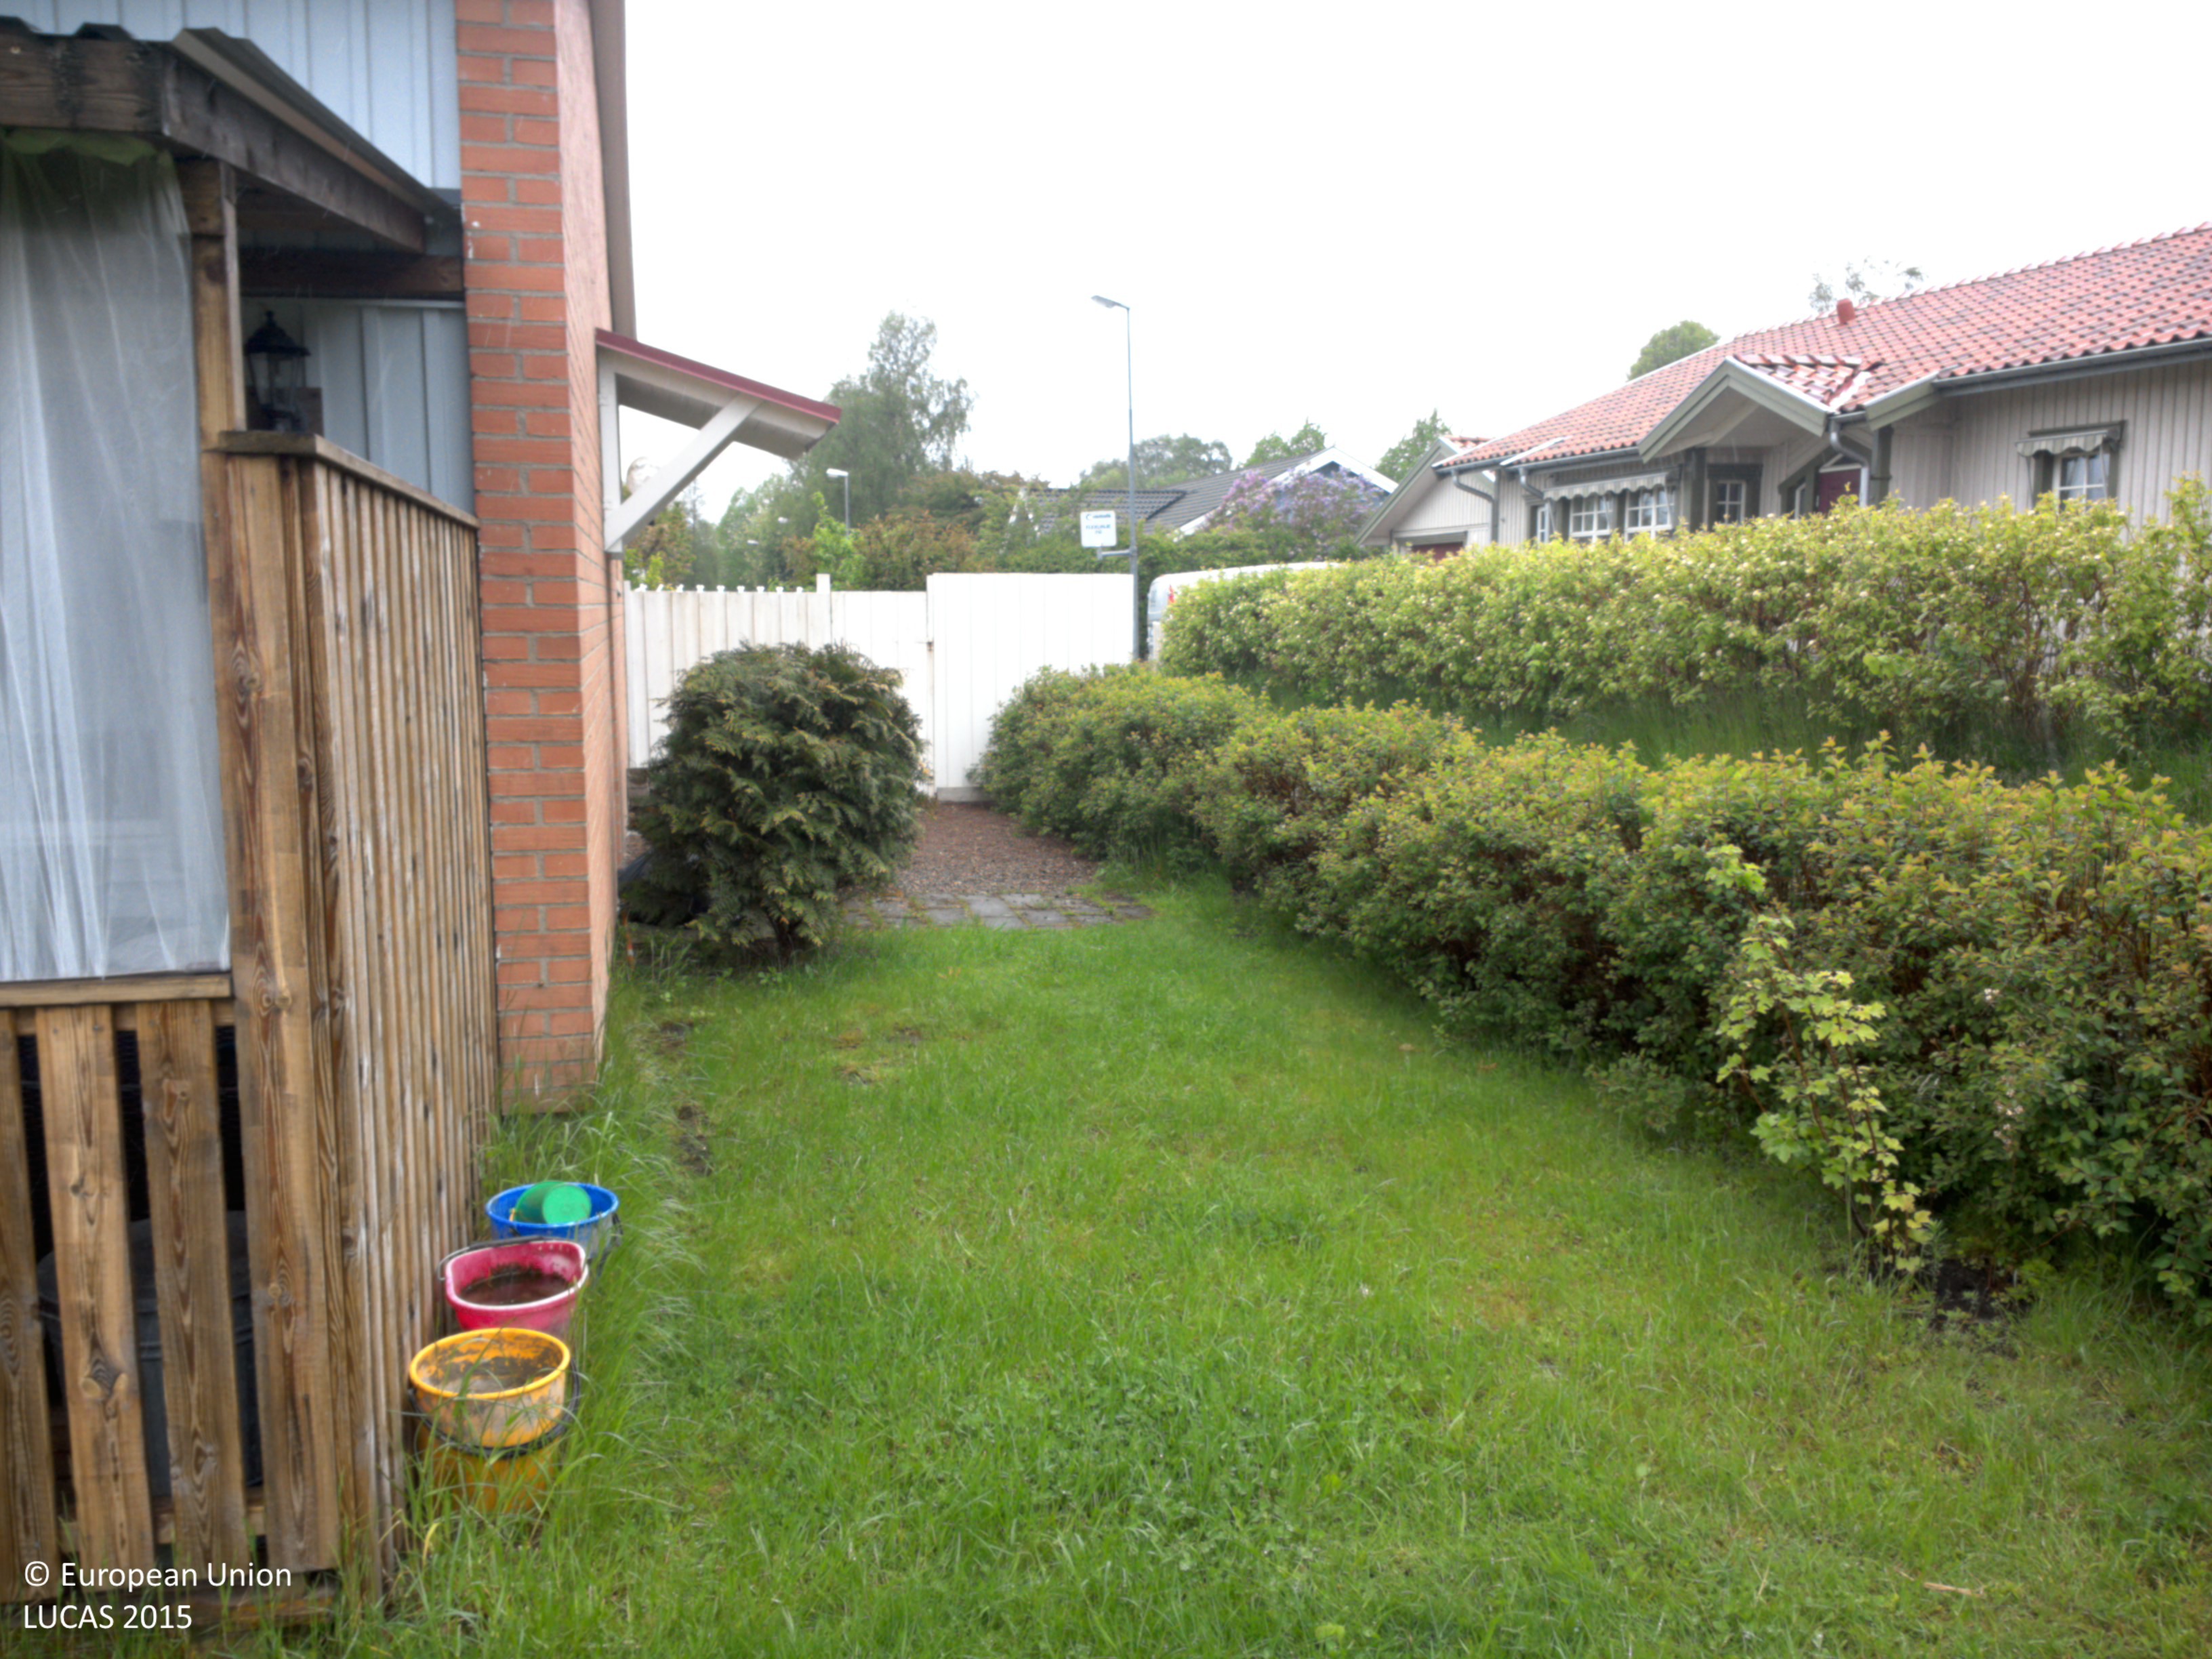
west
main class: Grassland
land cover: Grassland without tree/shrub cover
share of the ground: > 75 %
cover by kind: herbaceous plants 100 %
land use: Residential
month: June
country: SE
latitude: 57.8399
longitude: 12.3038
